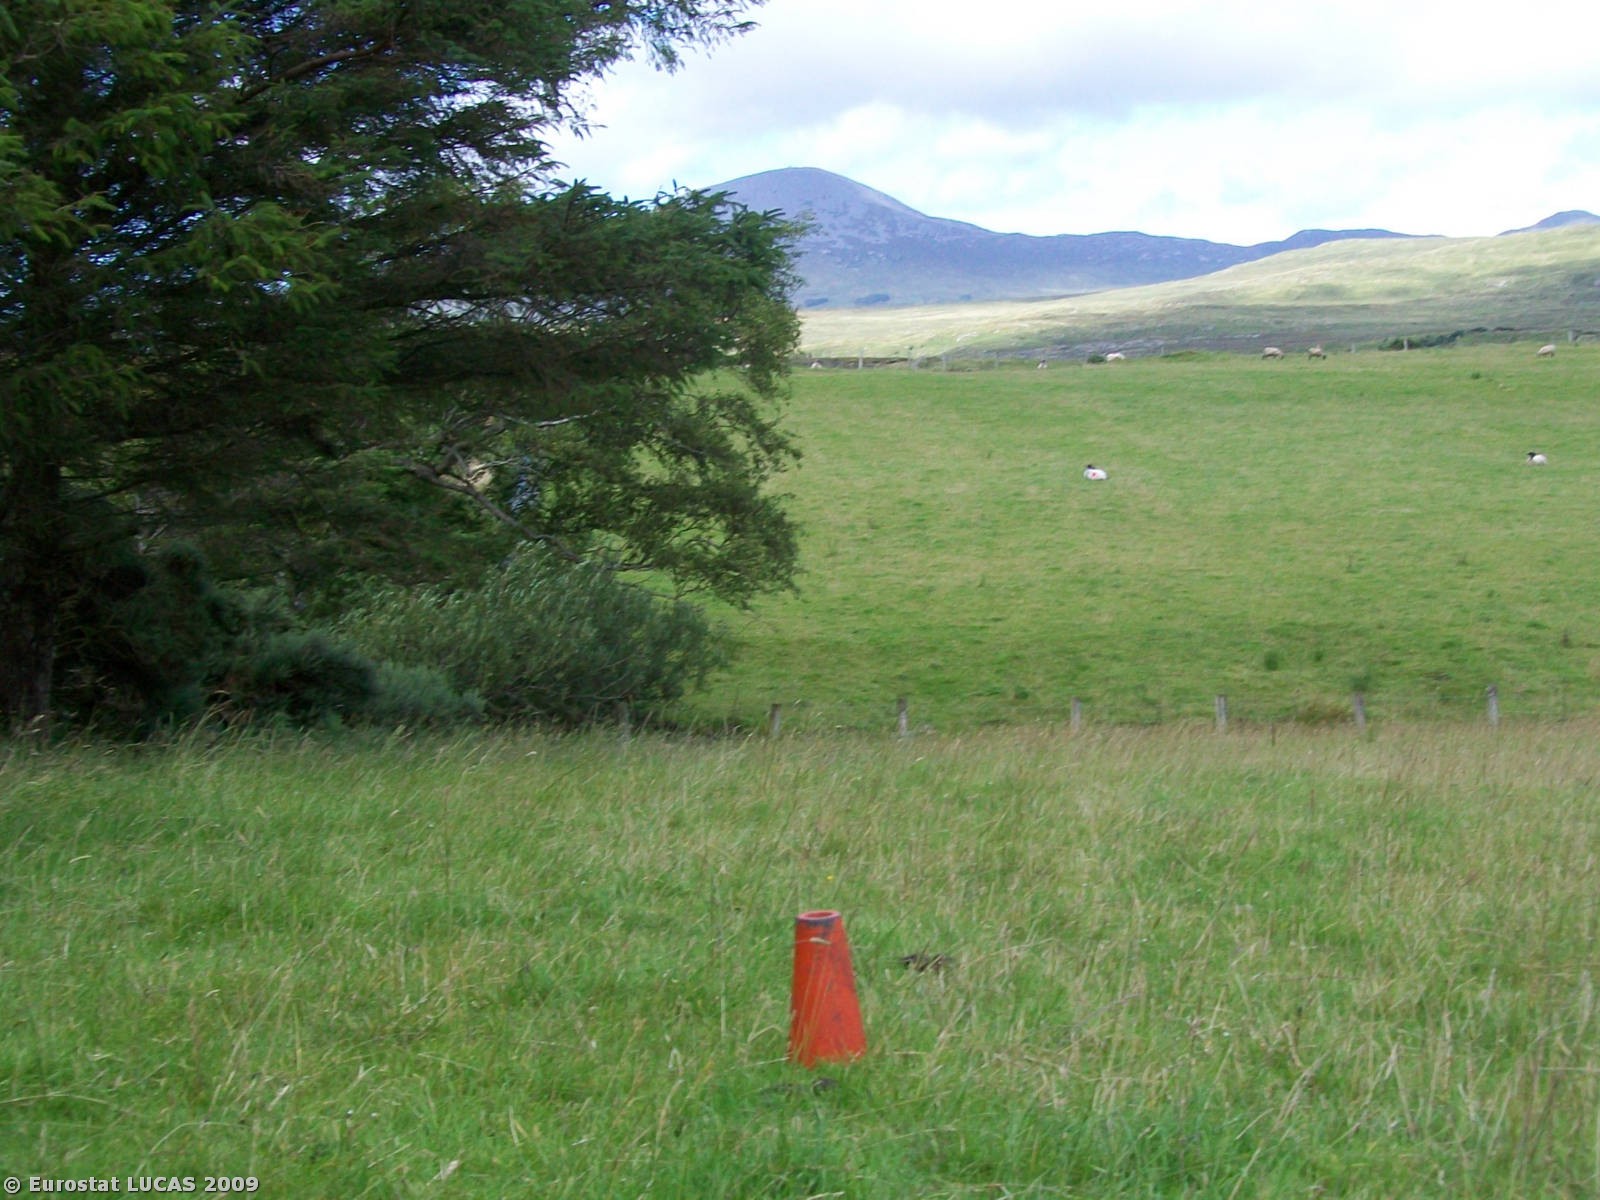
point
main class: Grassland
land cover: Grassland without tree/shrub cover
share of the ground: > 75 %
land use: Agriculture (excluding fallow land and kitchen gardens)
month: July
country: IE
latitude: 53.6982
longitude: -9.6405
